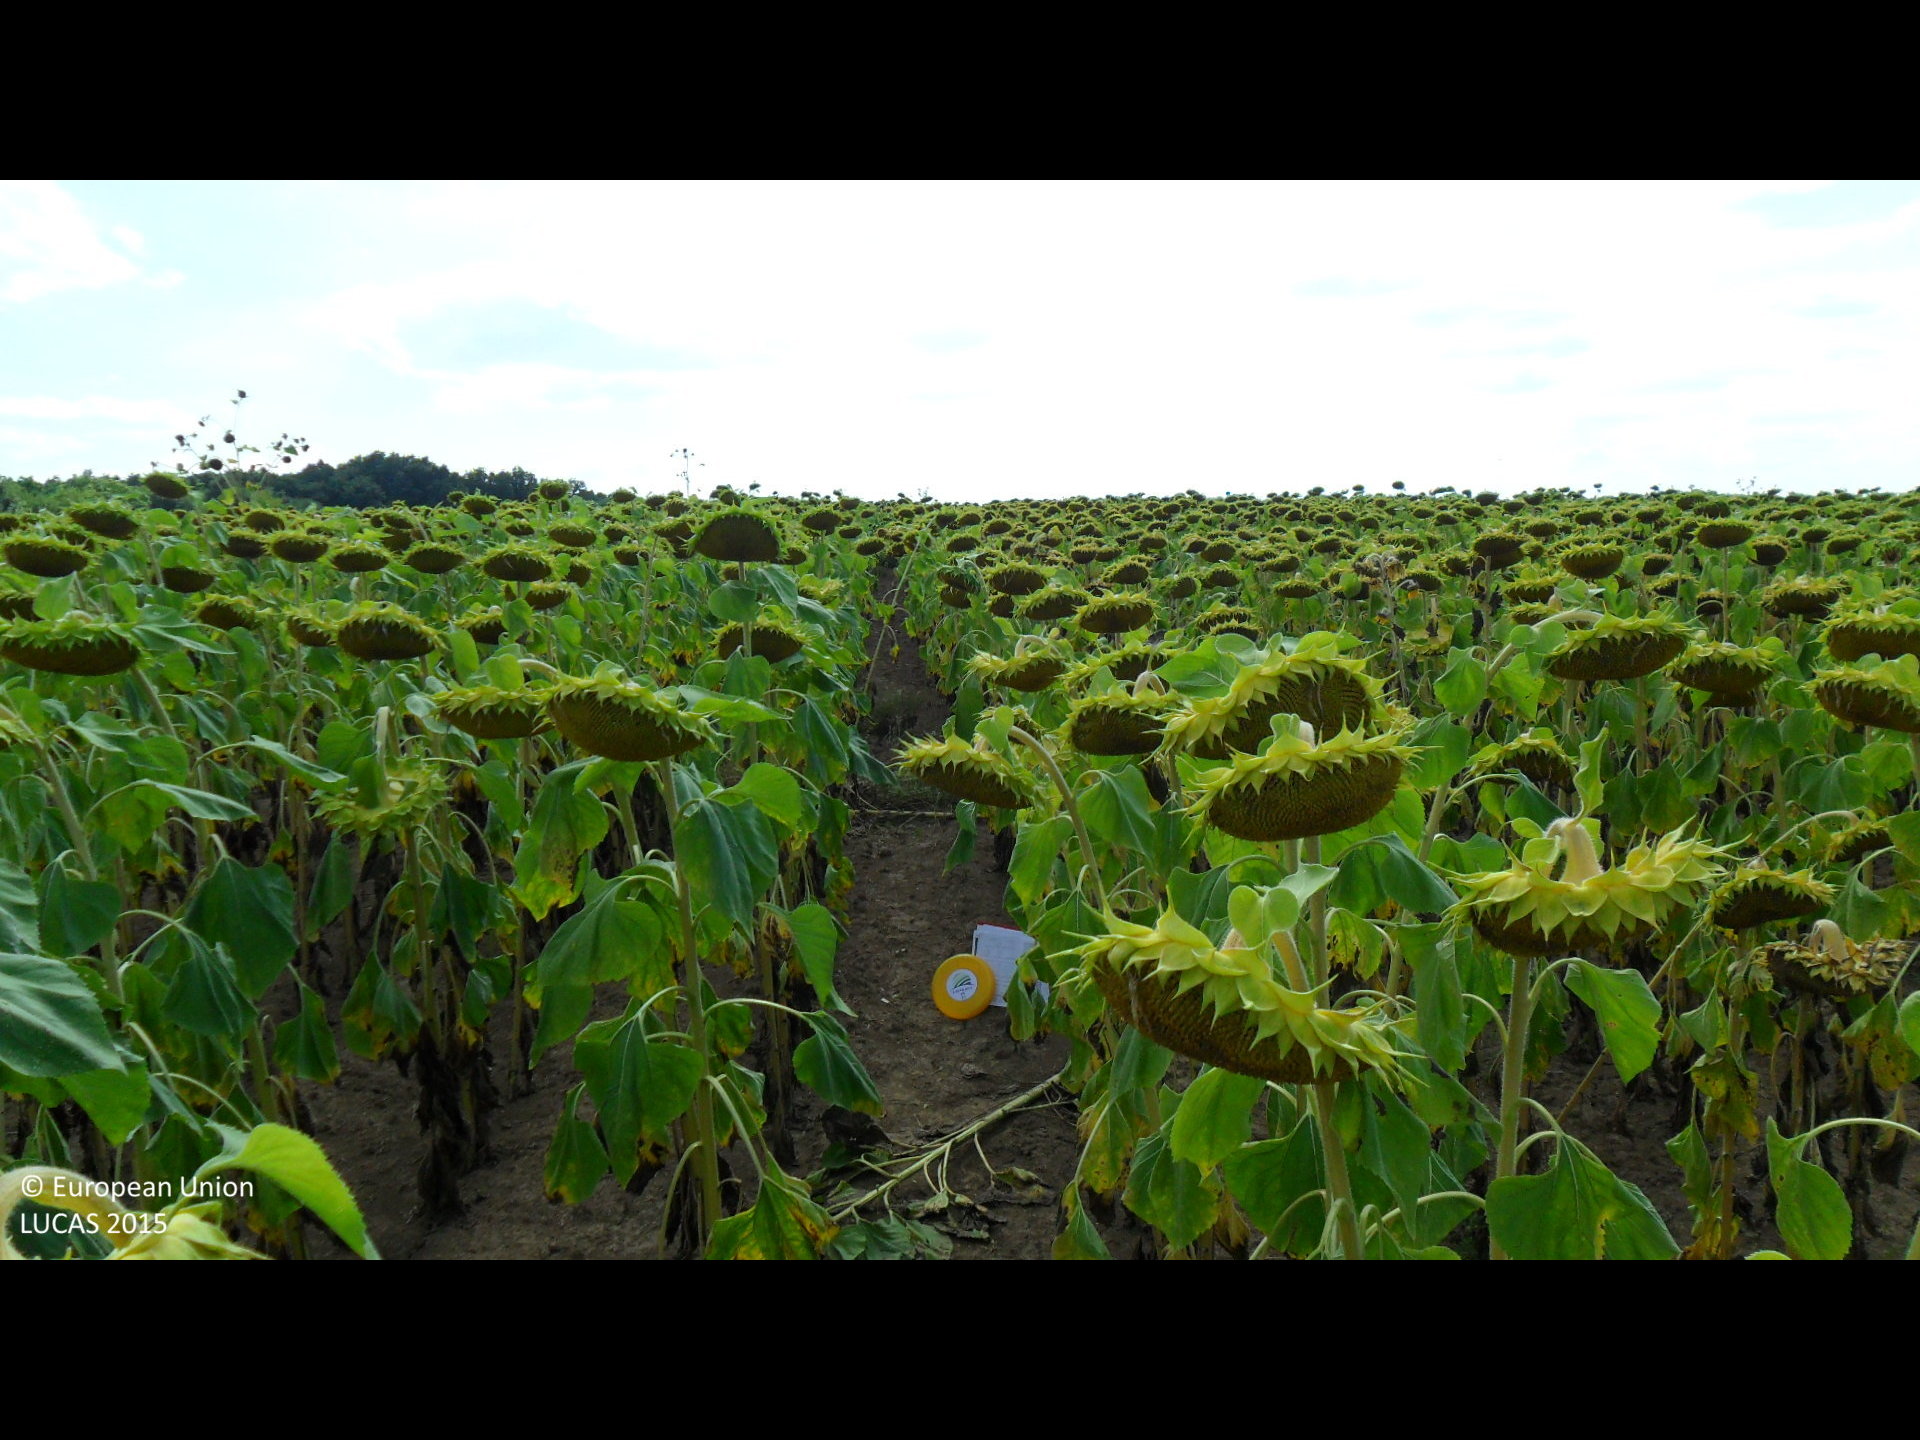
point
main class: Cropland
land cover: Sunflower
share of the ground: > 75 %
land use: Agriculture (excluding fallow land and kitchen gardens)
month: August
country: BG
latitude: 43.3908
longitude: 26.3586
